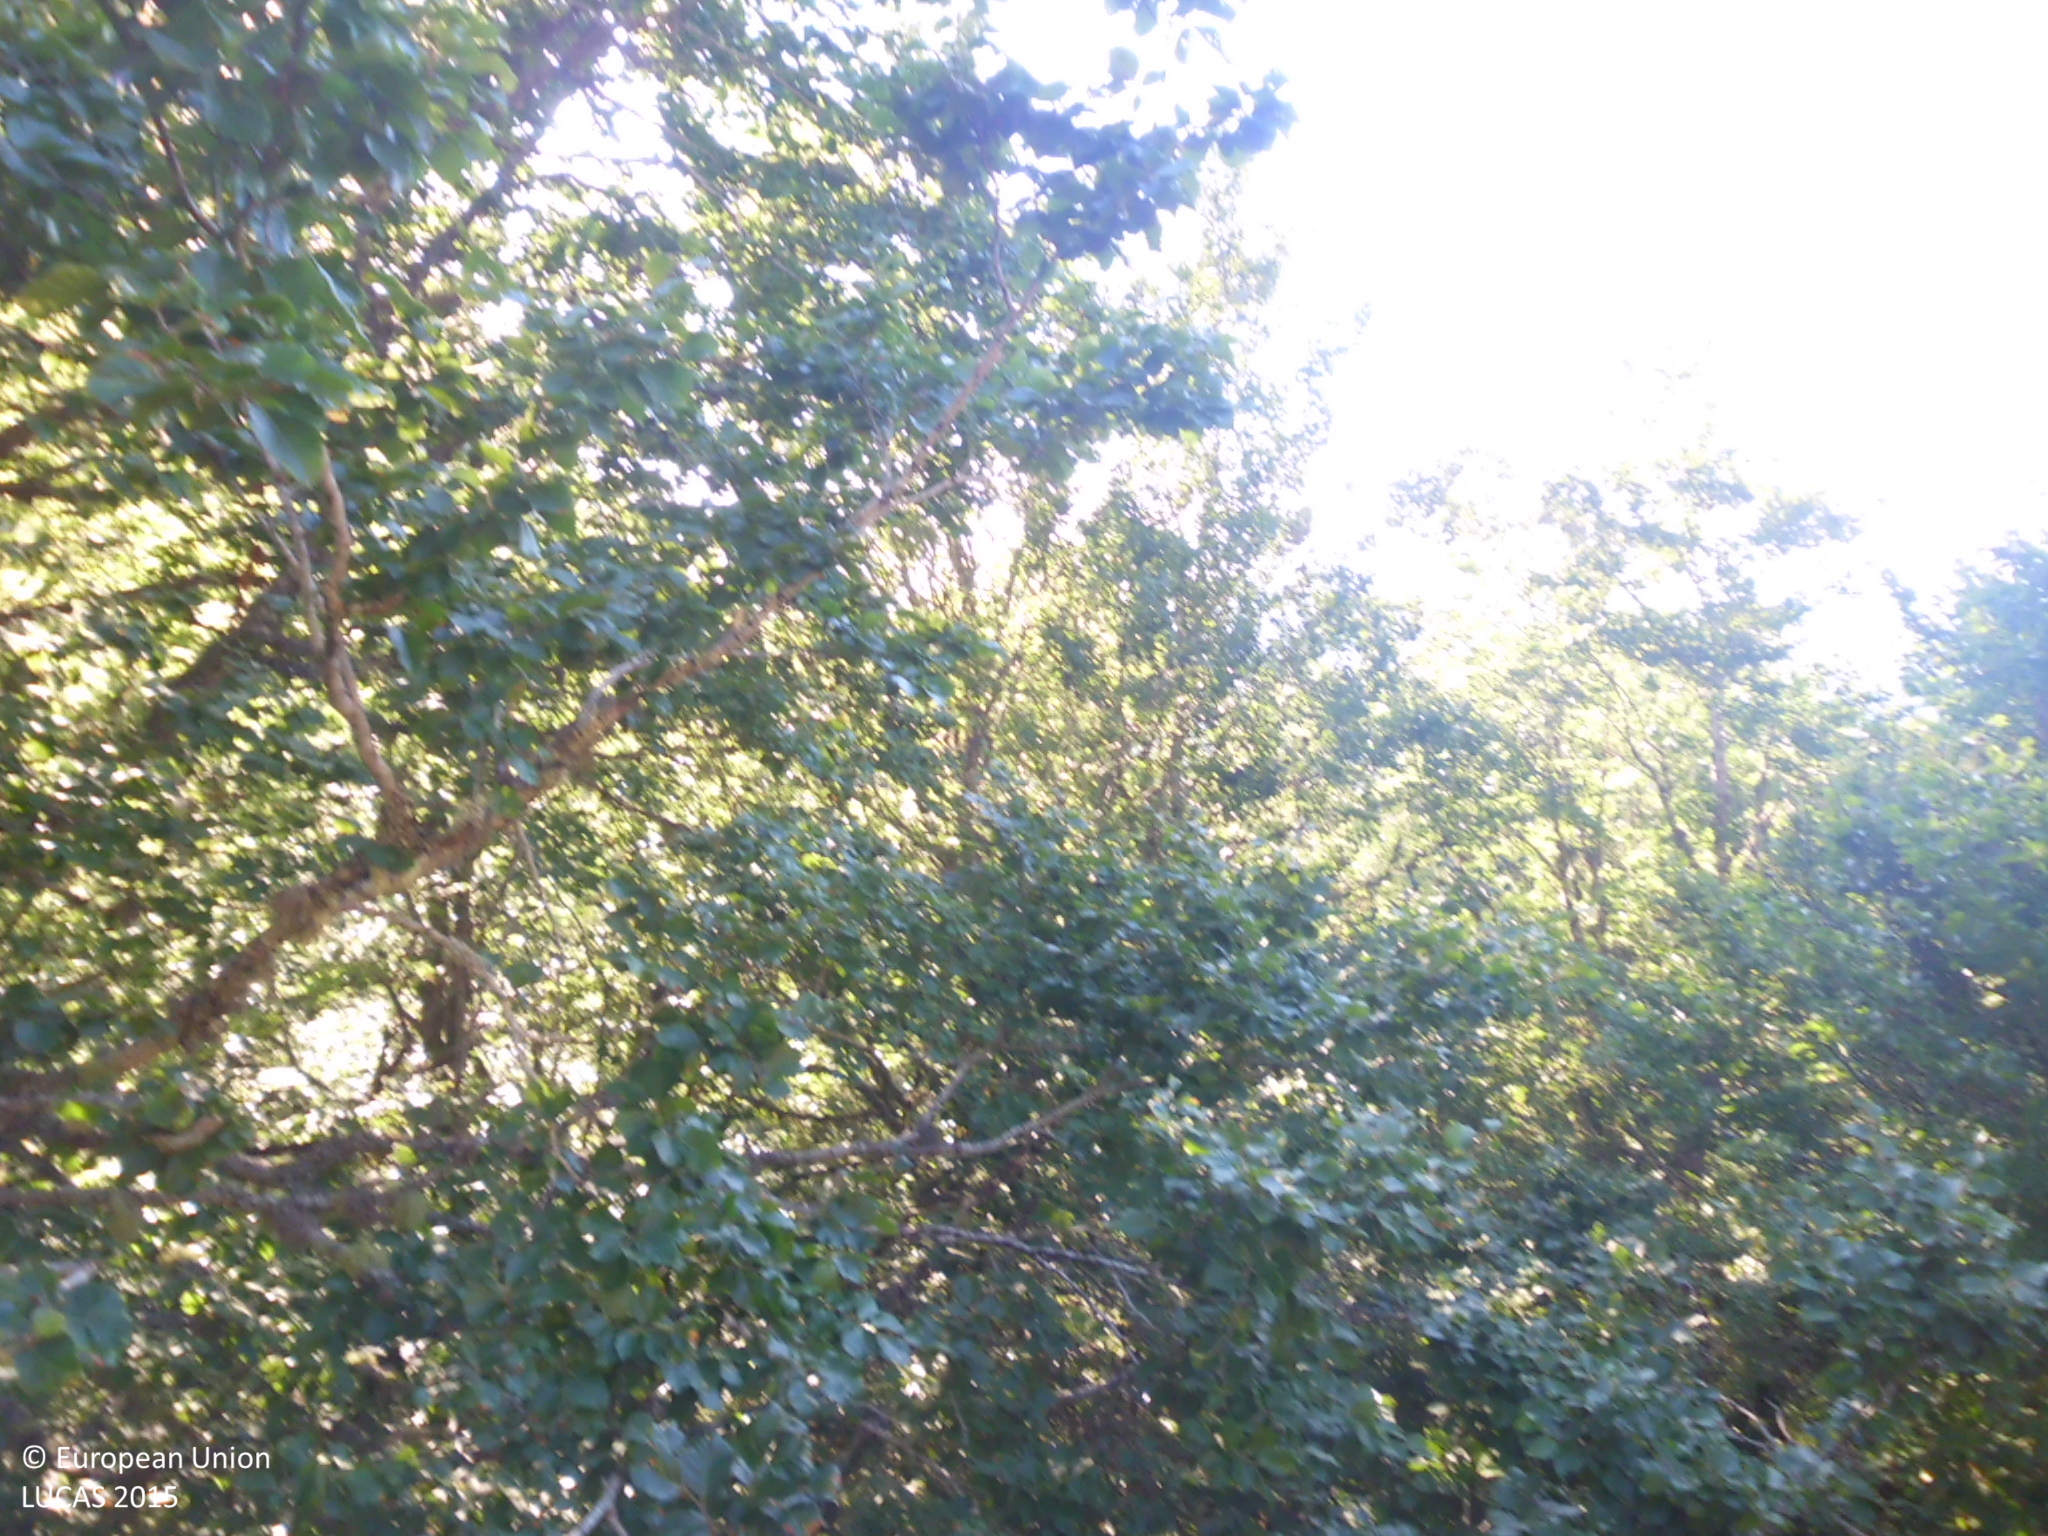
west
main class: Woodland
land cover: Broadleaved woodland
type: acidophilous oak and oak-birch forest
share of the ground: > 75 %
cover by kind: broadleaved forest trees 95 %, herbaceous plants 5 %
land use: Semi-natural and natural areas not in use
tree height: > 5 m
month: June
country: ES
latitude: 42.9303
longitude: -4.9514
